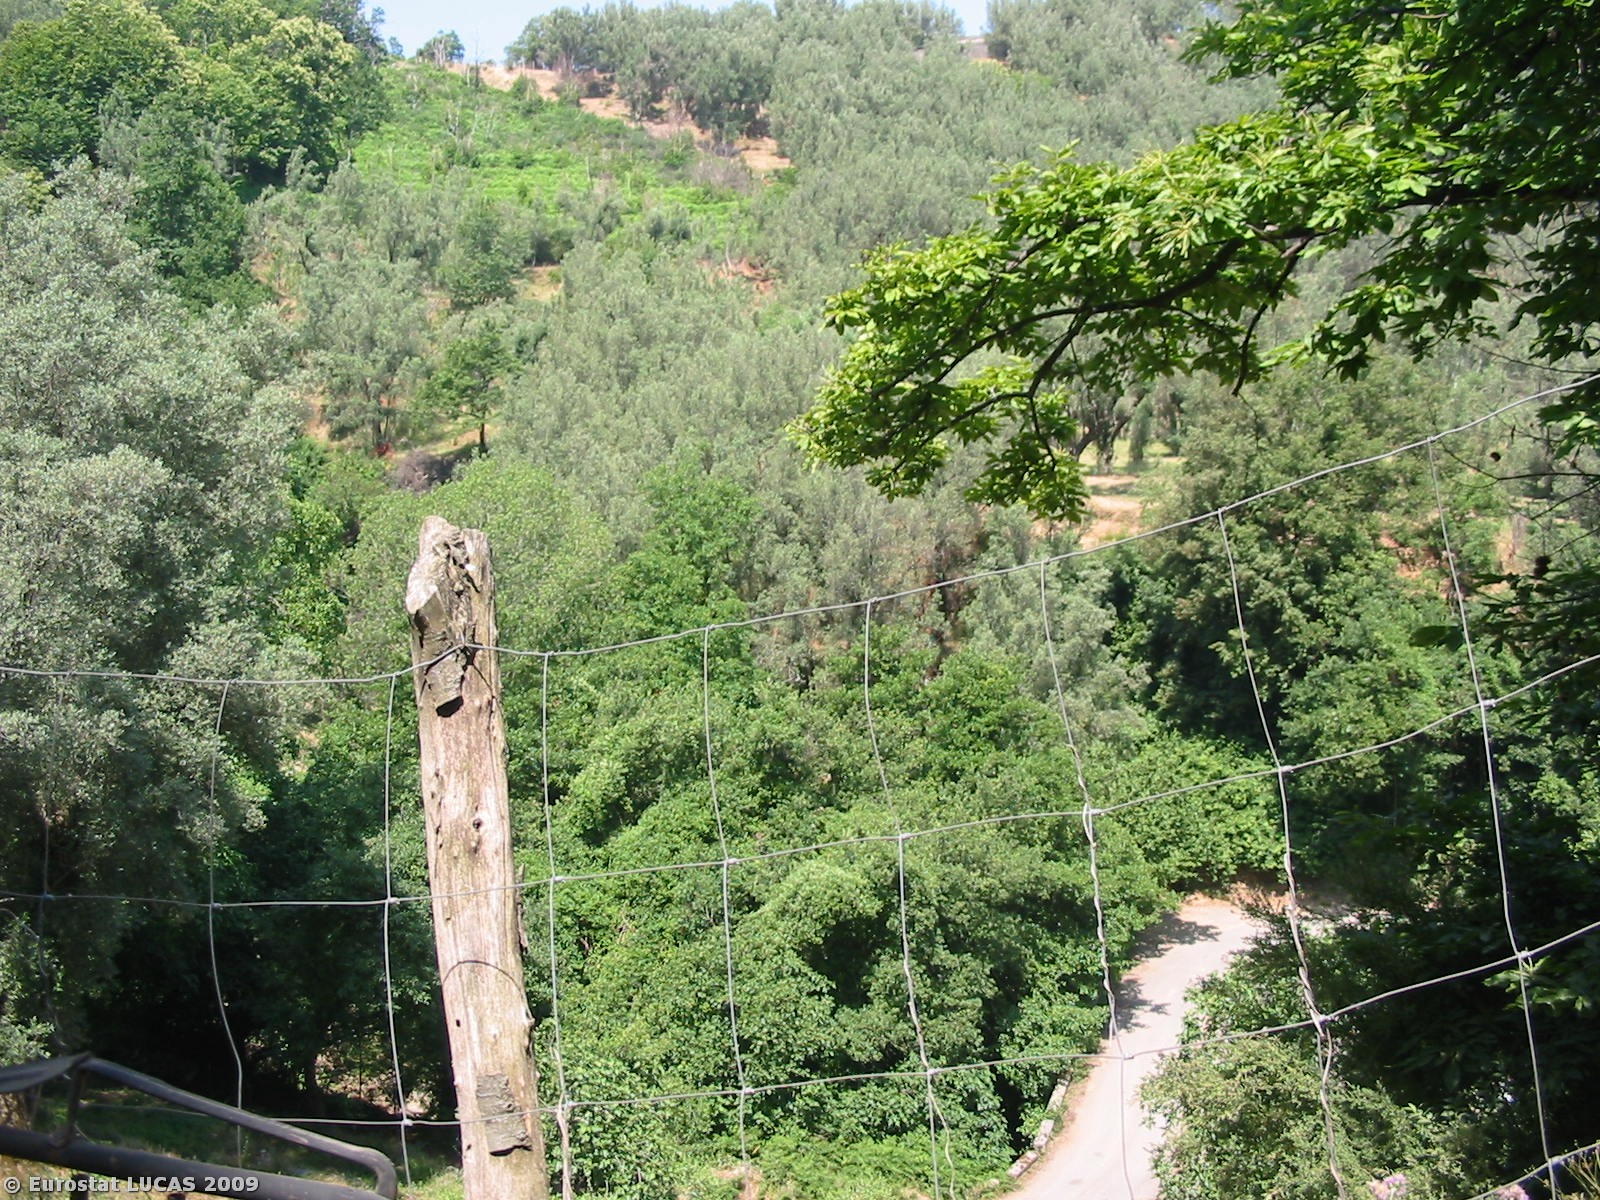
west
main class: Cropland
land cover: Olive groves
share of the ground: 50 - 75 %
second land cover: Spontaneously vegetated surfaces
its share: > 75 %
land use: Agriculture (excluding fallow land and kitchen gardens)
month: June
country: IT
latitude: 38.2348
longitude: 15.9389
